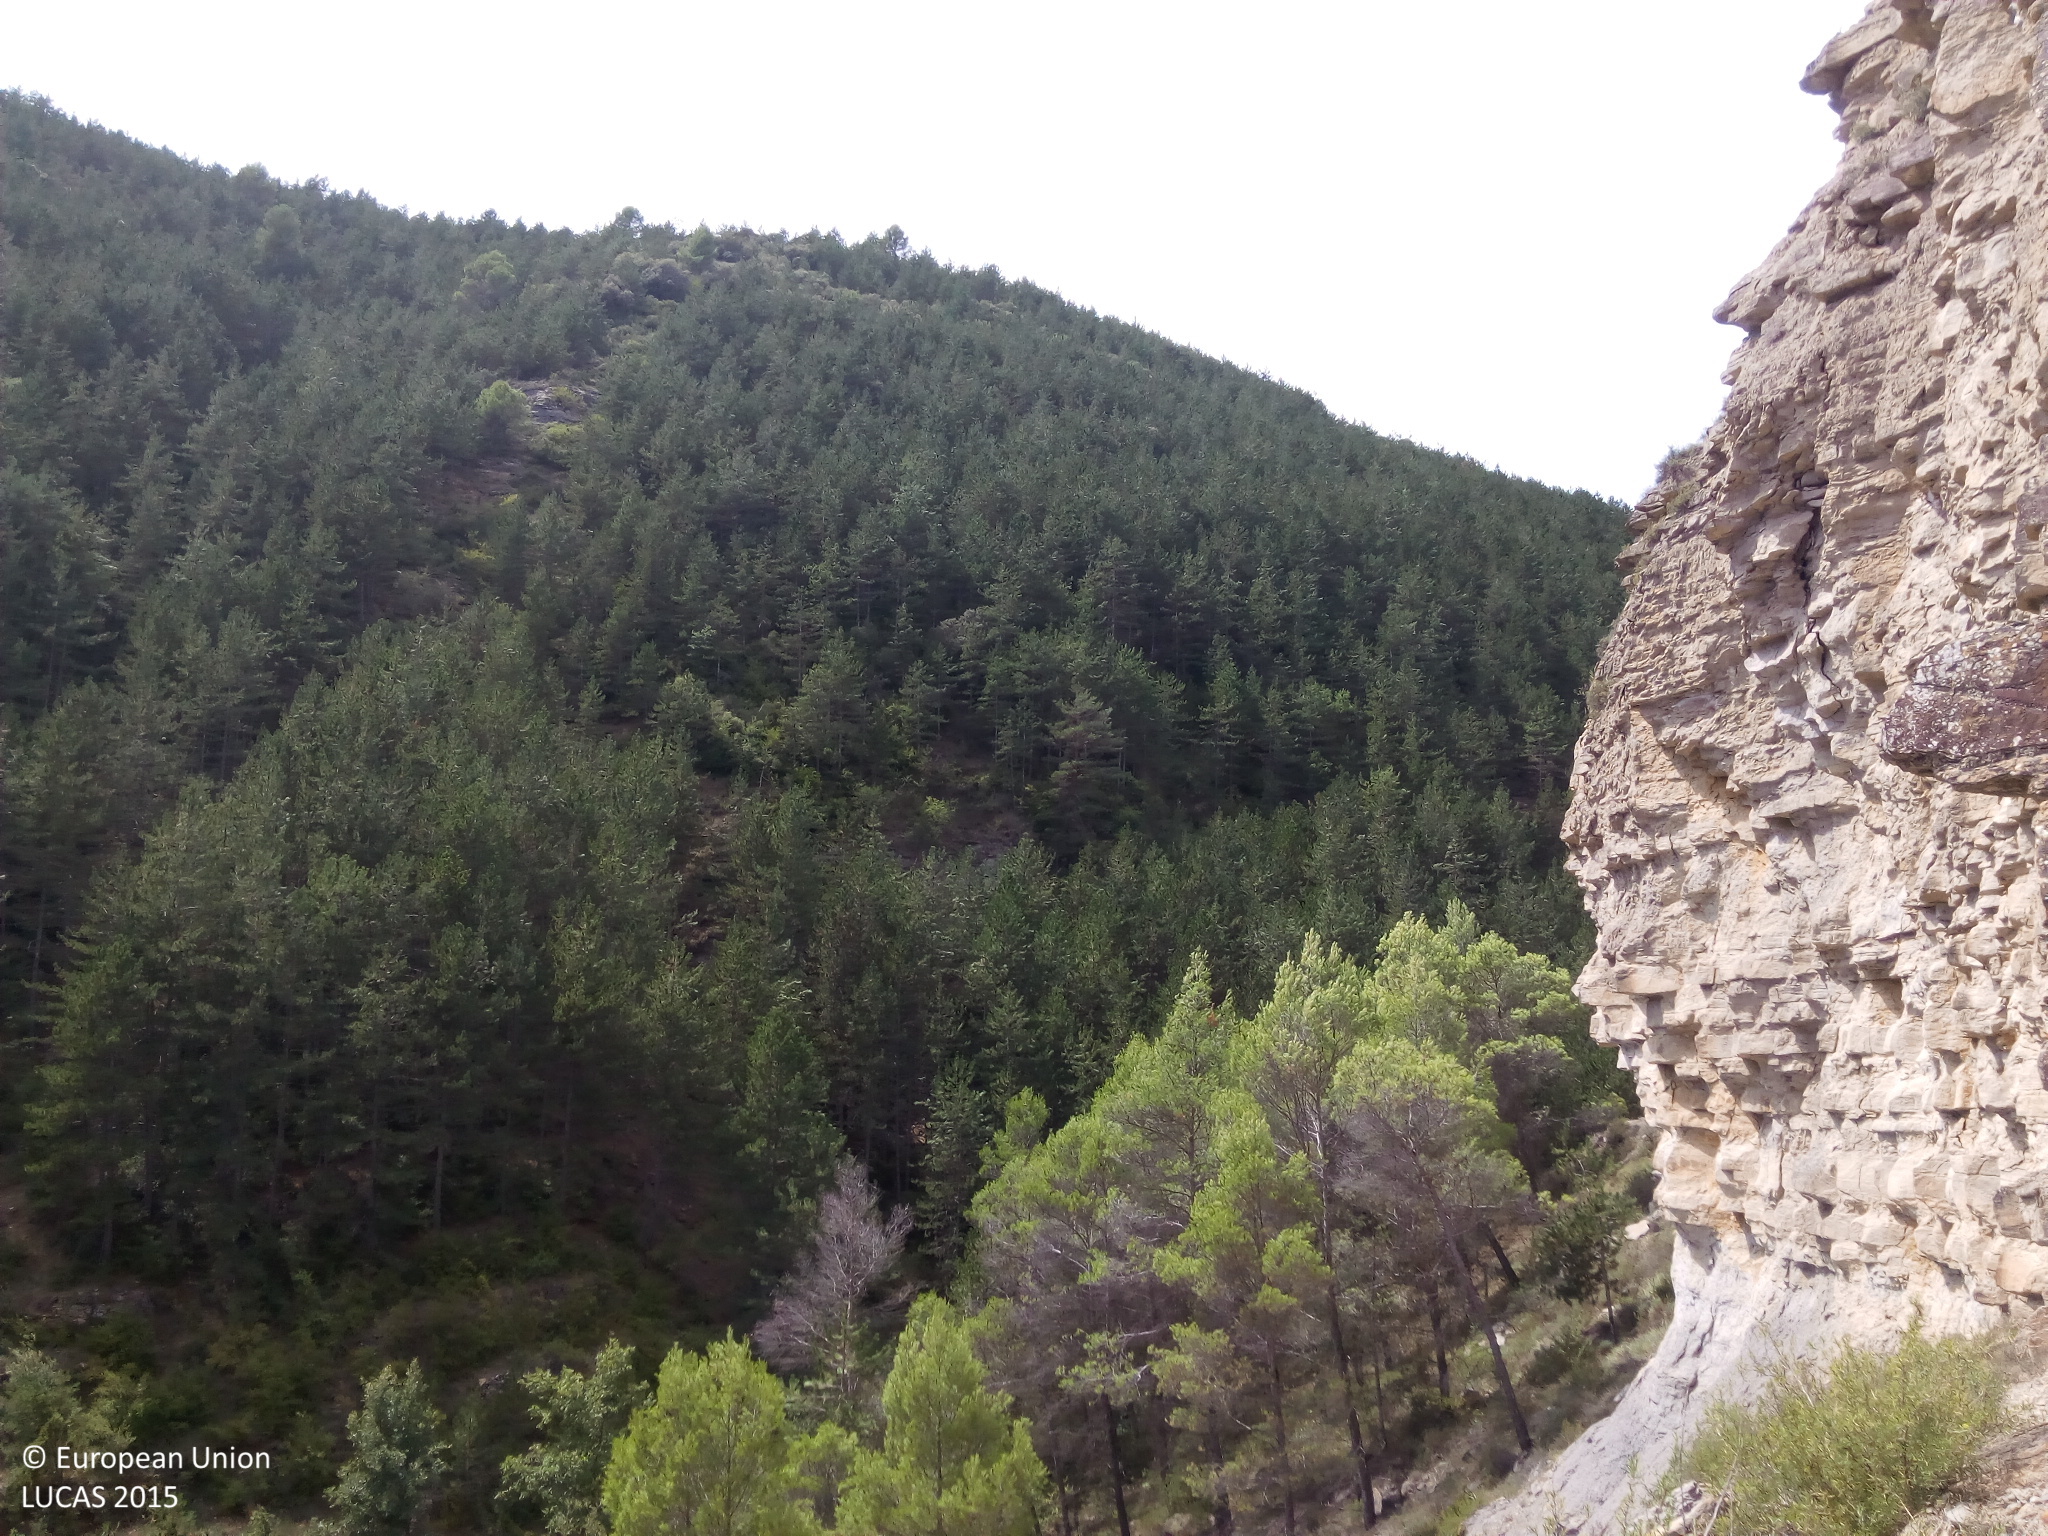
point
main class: Woodland
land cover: Pine dominated coniferous woodland
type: coniferous forest of the mediterranean region
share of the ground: > 75 %
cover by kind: coniferous forest trees 100 %
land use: Semi-natural and natural areas not in use
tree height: > 5 m
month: August
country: ES
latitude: 42.2643
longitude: 0.3433
